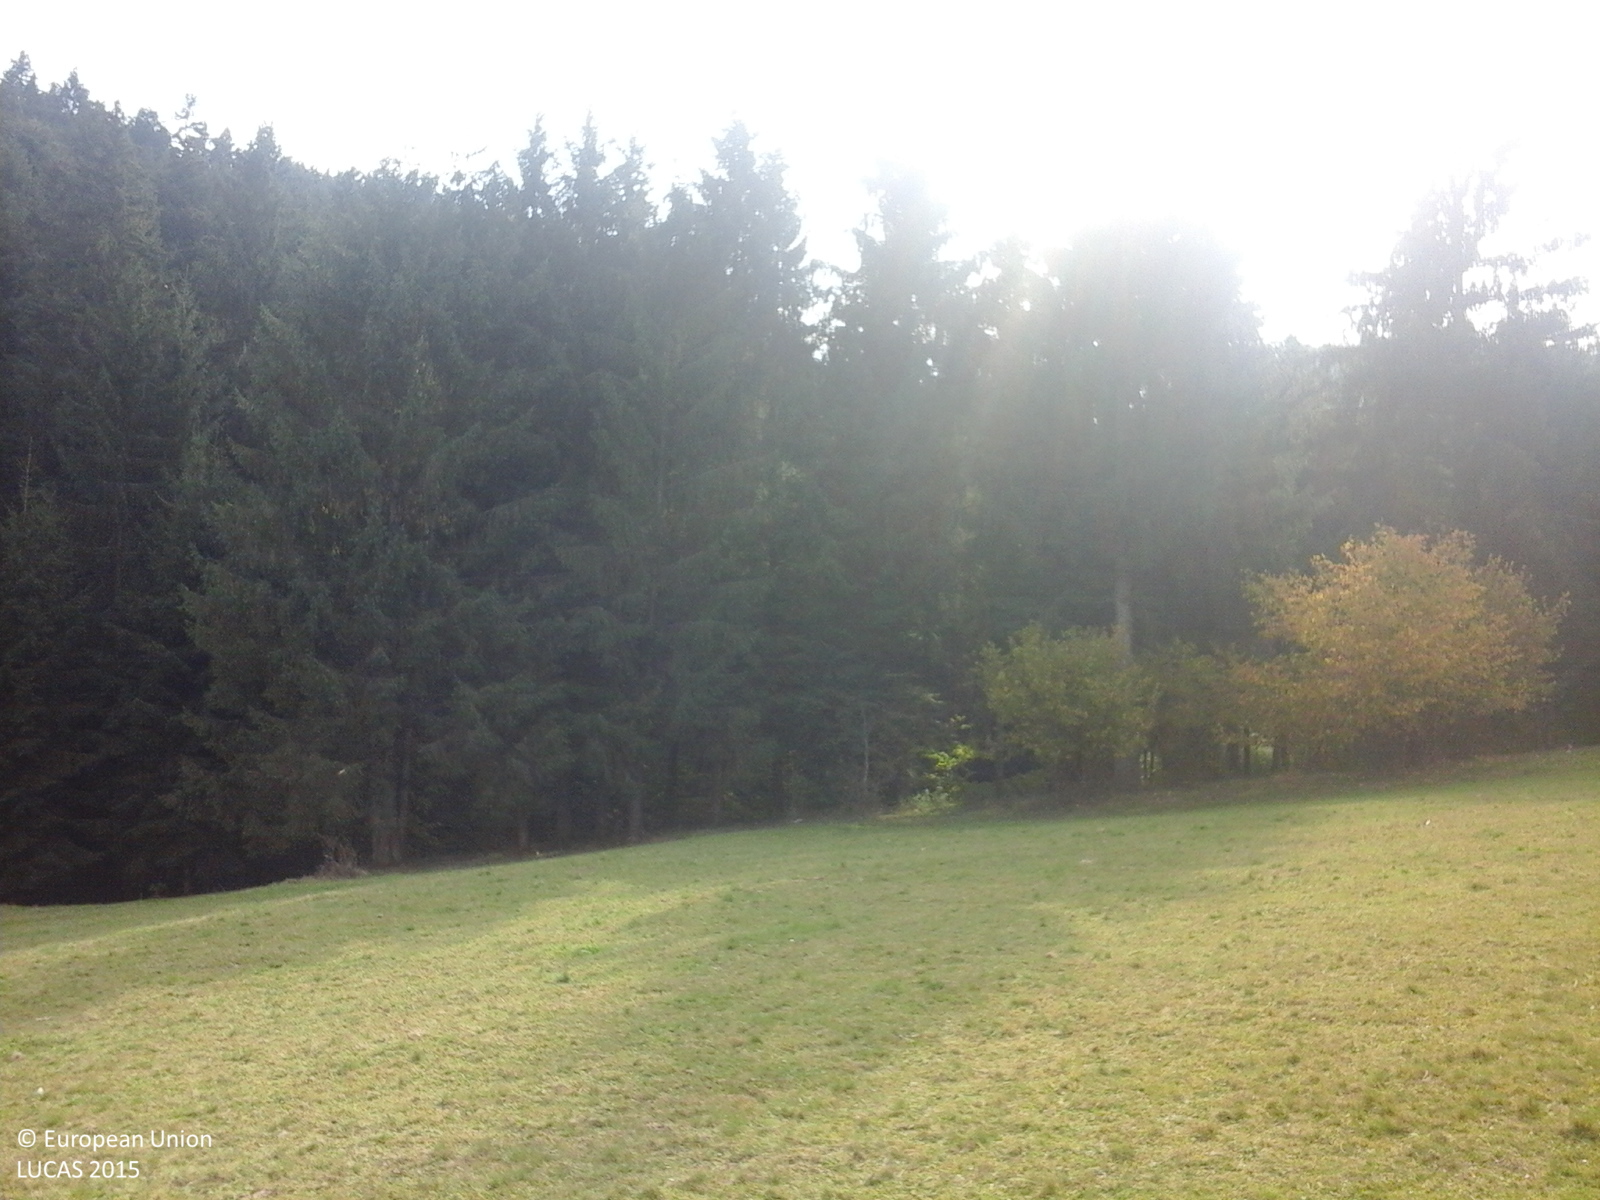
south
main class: Grassland
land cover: Grassland without tree/shrub cover
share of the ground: > 75 %
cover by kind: herbaceous plants 100 %
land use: Agriculture (excluding fallow land and kitchen gardens)
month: October
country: RO
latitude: 46.3241
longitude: 25.7916
